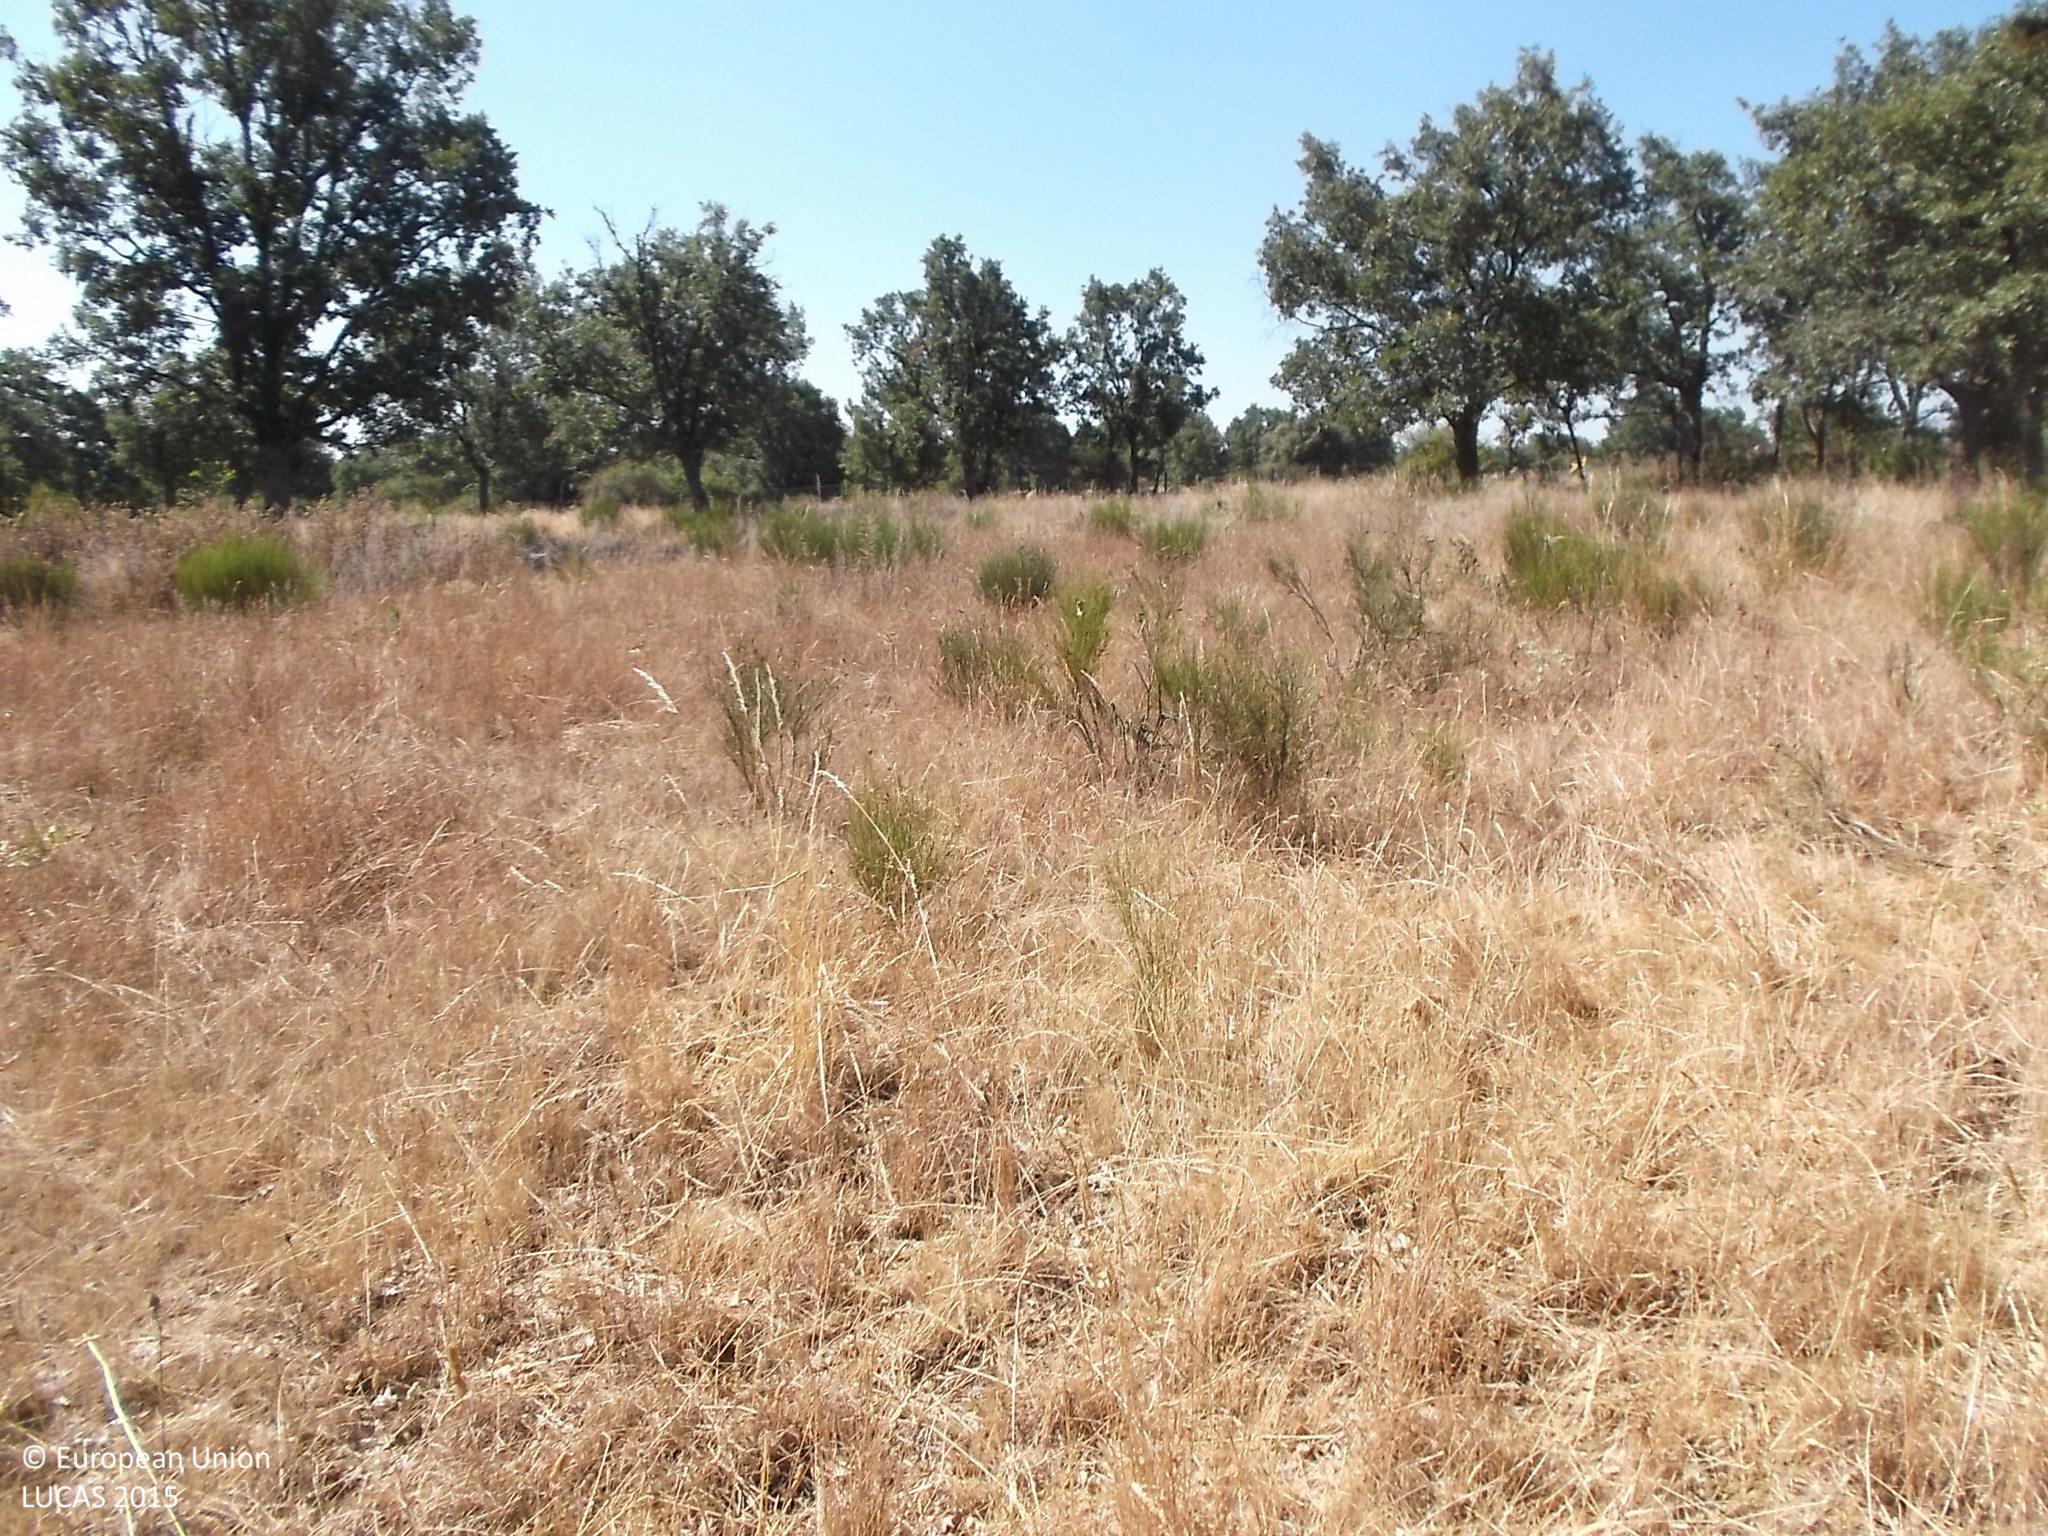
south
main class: Woodland
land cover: Broadleaved woodland
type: broadleaved evergreen forest
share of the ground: 10 - 25 %
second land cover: Shrubland without tree cover
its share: 25 - 50 %
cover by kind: shrubs 40 %, herbaceous plants 35 %, broadleaved forest trees 25 %
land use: Forestry
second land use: Agriculture (excluding fallow land and kitchen gardens)
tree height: < 5 m
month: July
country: ES
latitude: 41.3543
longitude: -5.9987
